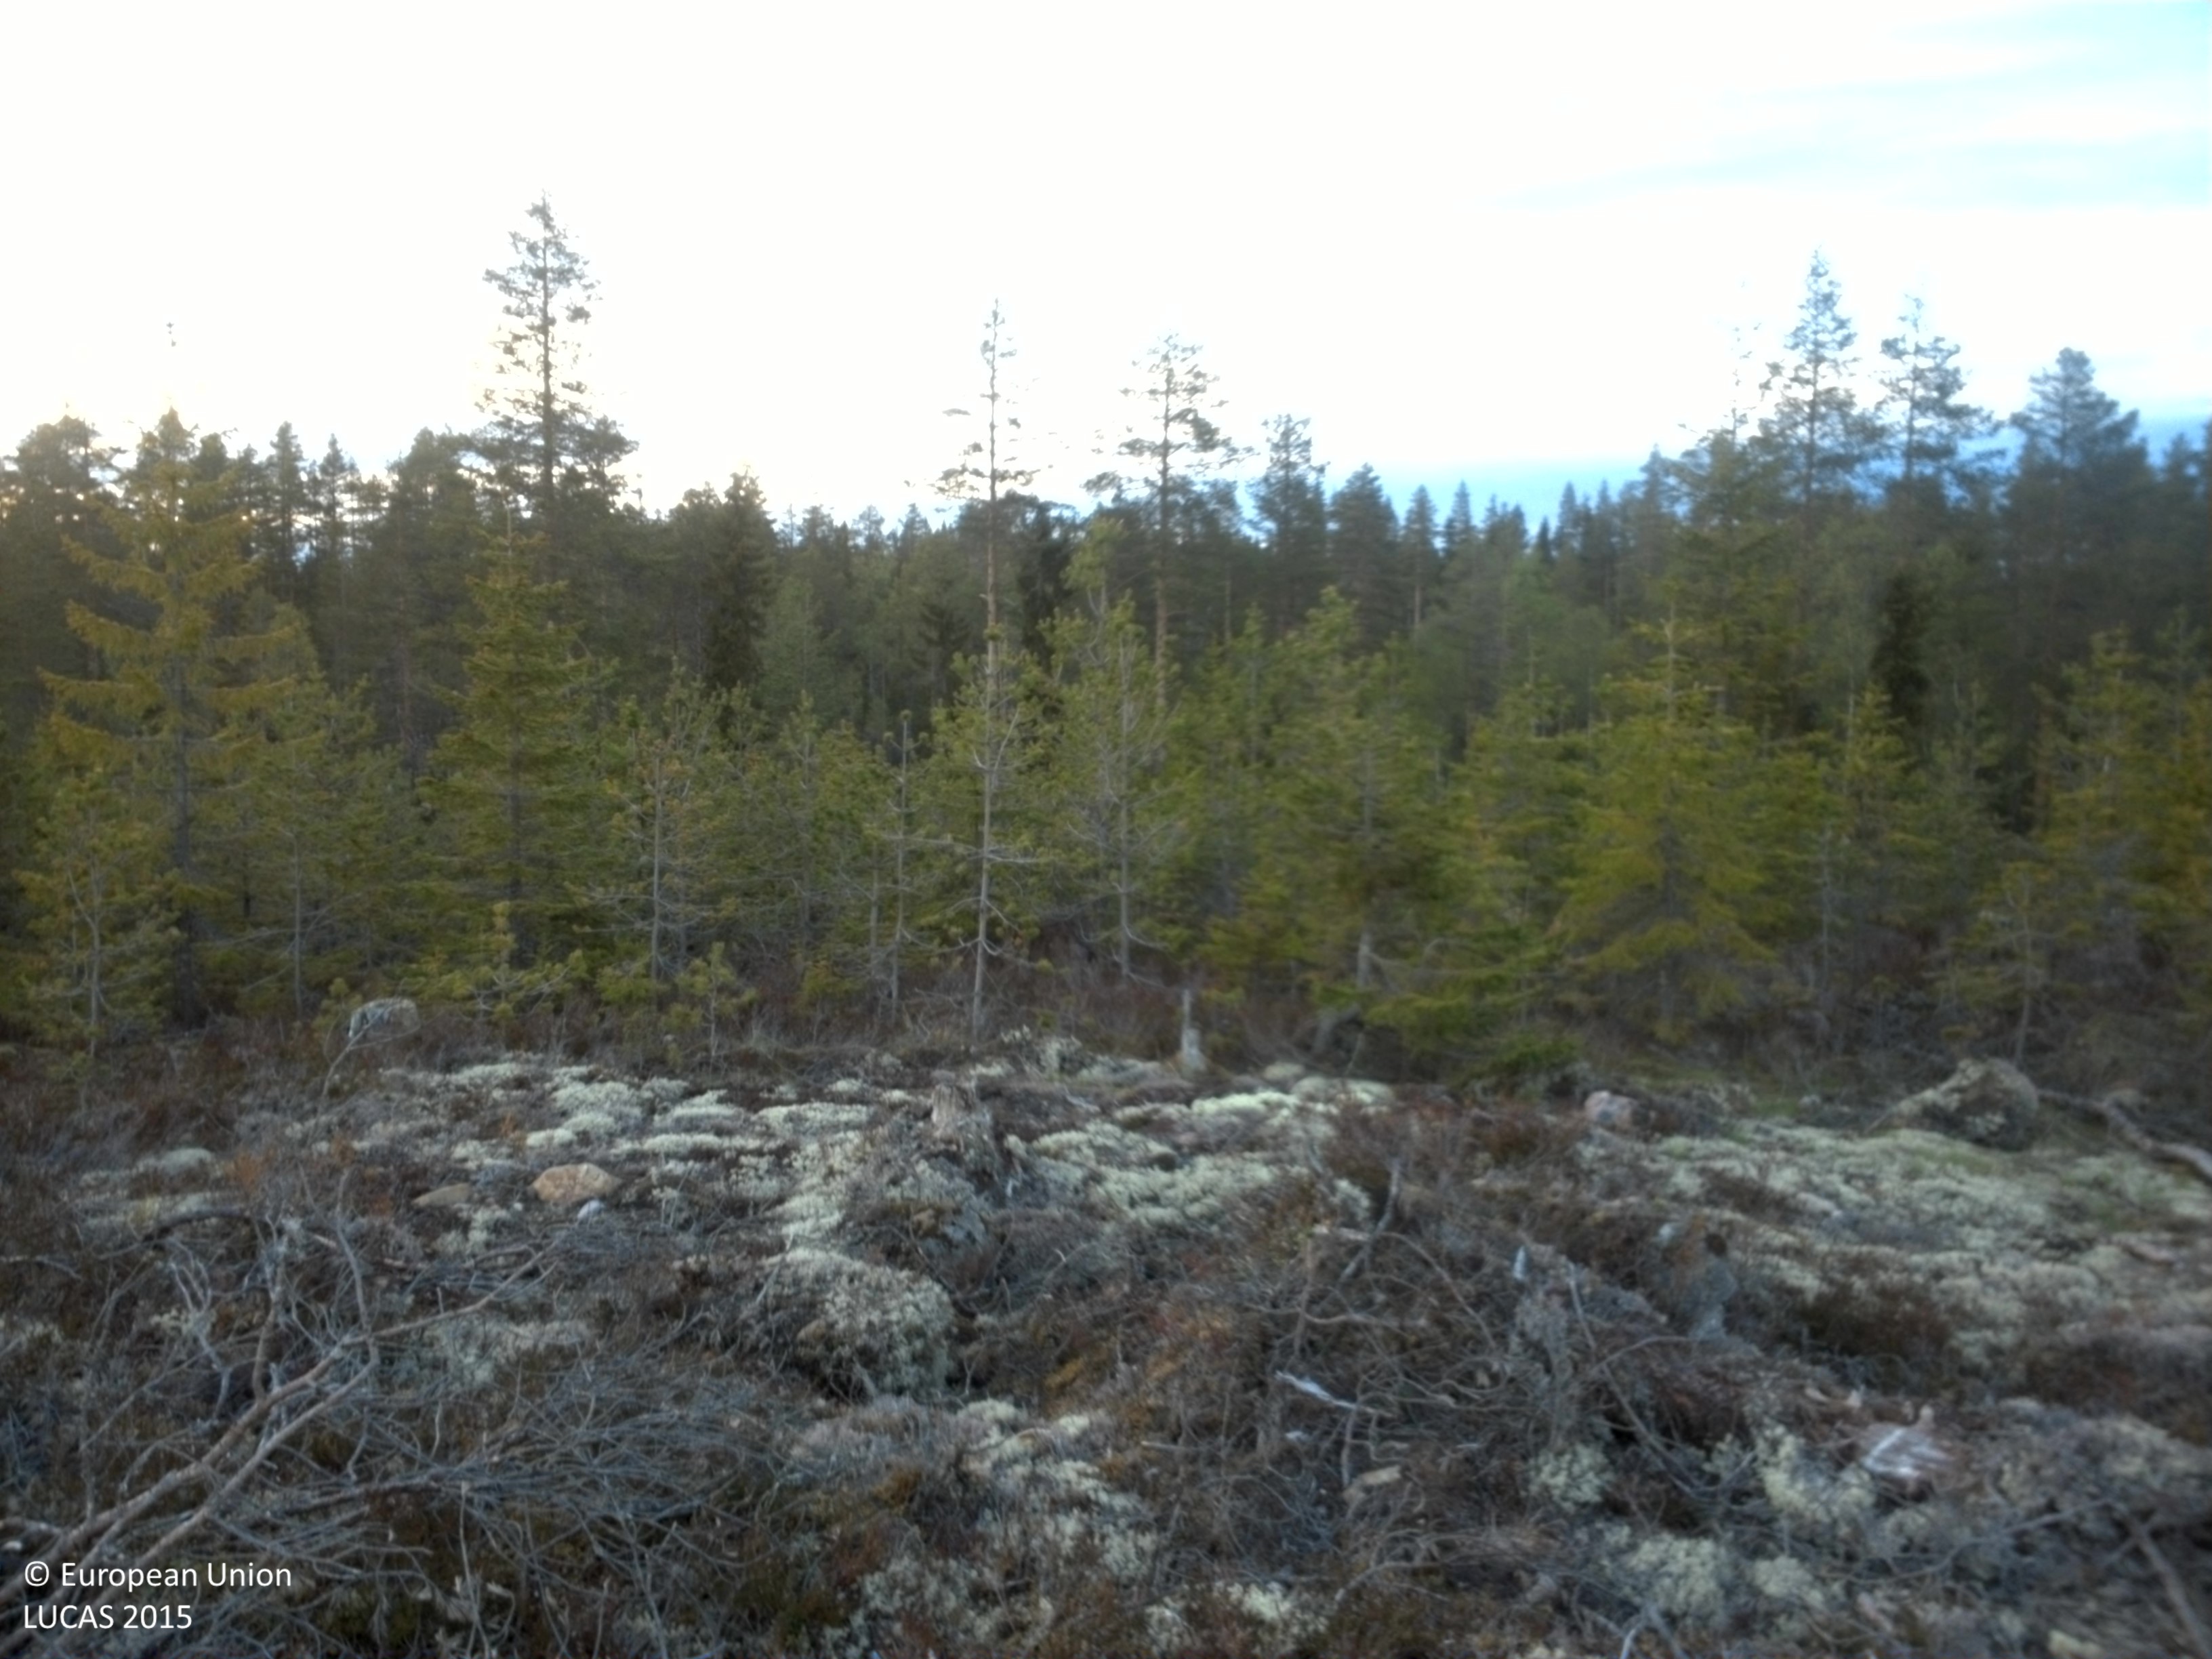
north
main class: Shrubland
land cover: Shrubland with sparse tree cover
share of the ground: 50 - 75 %
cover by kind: shrubs 55 %, lichens and mosses 10 %, consolidated bare surface 10 %, coniferous forest trees 5 %
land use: Forestry
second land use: Amenities, museums, leisure
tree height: > 5 m
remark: Clear cut
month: June
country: SE
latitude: 61.1321
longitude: 13.3494
